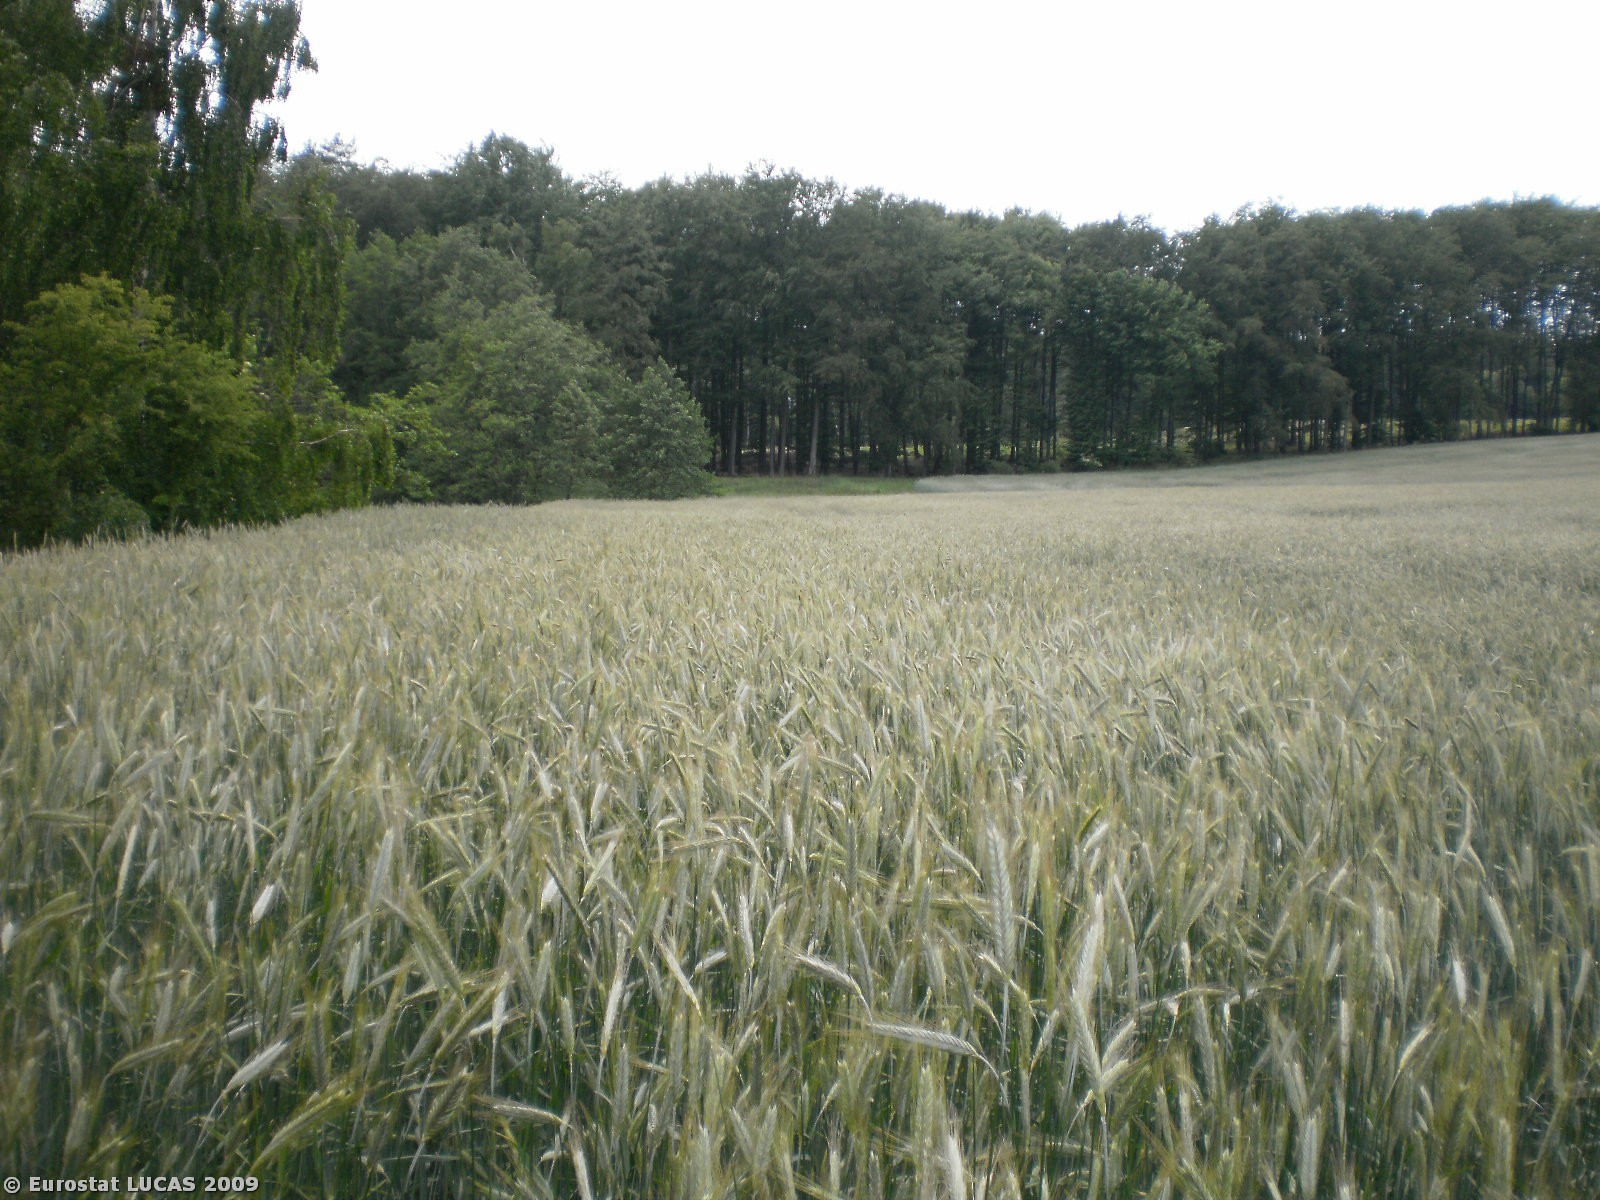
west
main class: Cropland
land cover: Rye
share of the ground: > 75 %
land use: Agriculture (excluding fallow land and kitchen gardens)
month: June
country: PL
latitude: 54.7502
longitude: 17.9206
